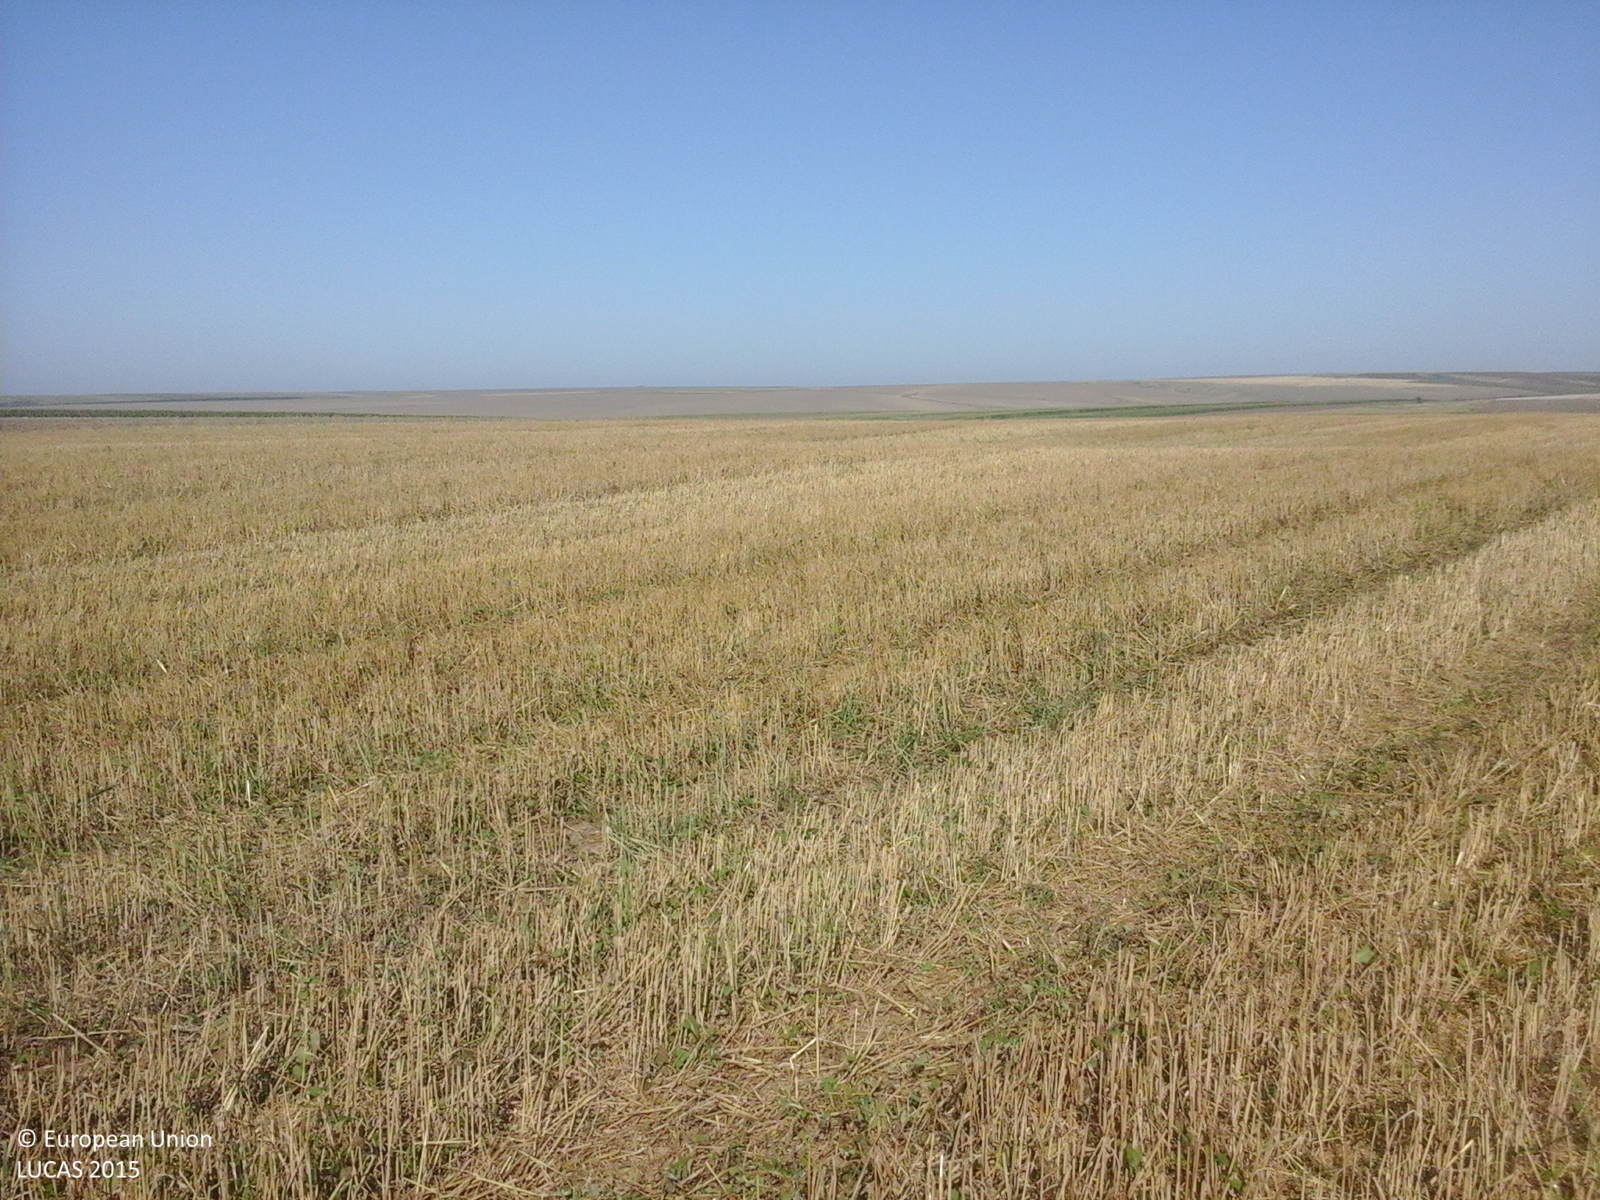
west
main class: Cropland
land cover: Common wheat
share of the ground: > 75 %
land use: Agriculture (excluding fallow land and kitchen gardens)
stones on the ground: < 10 %
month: August
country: RO
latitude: 44.6508
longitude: 28.1583
